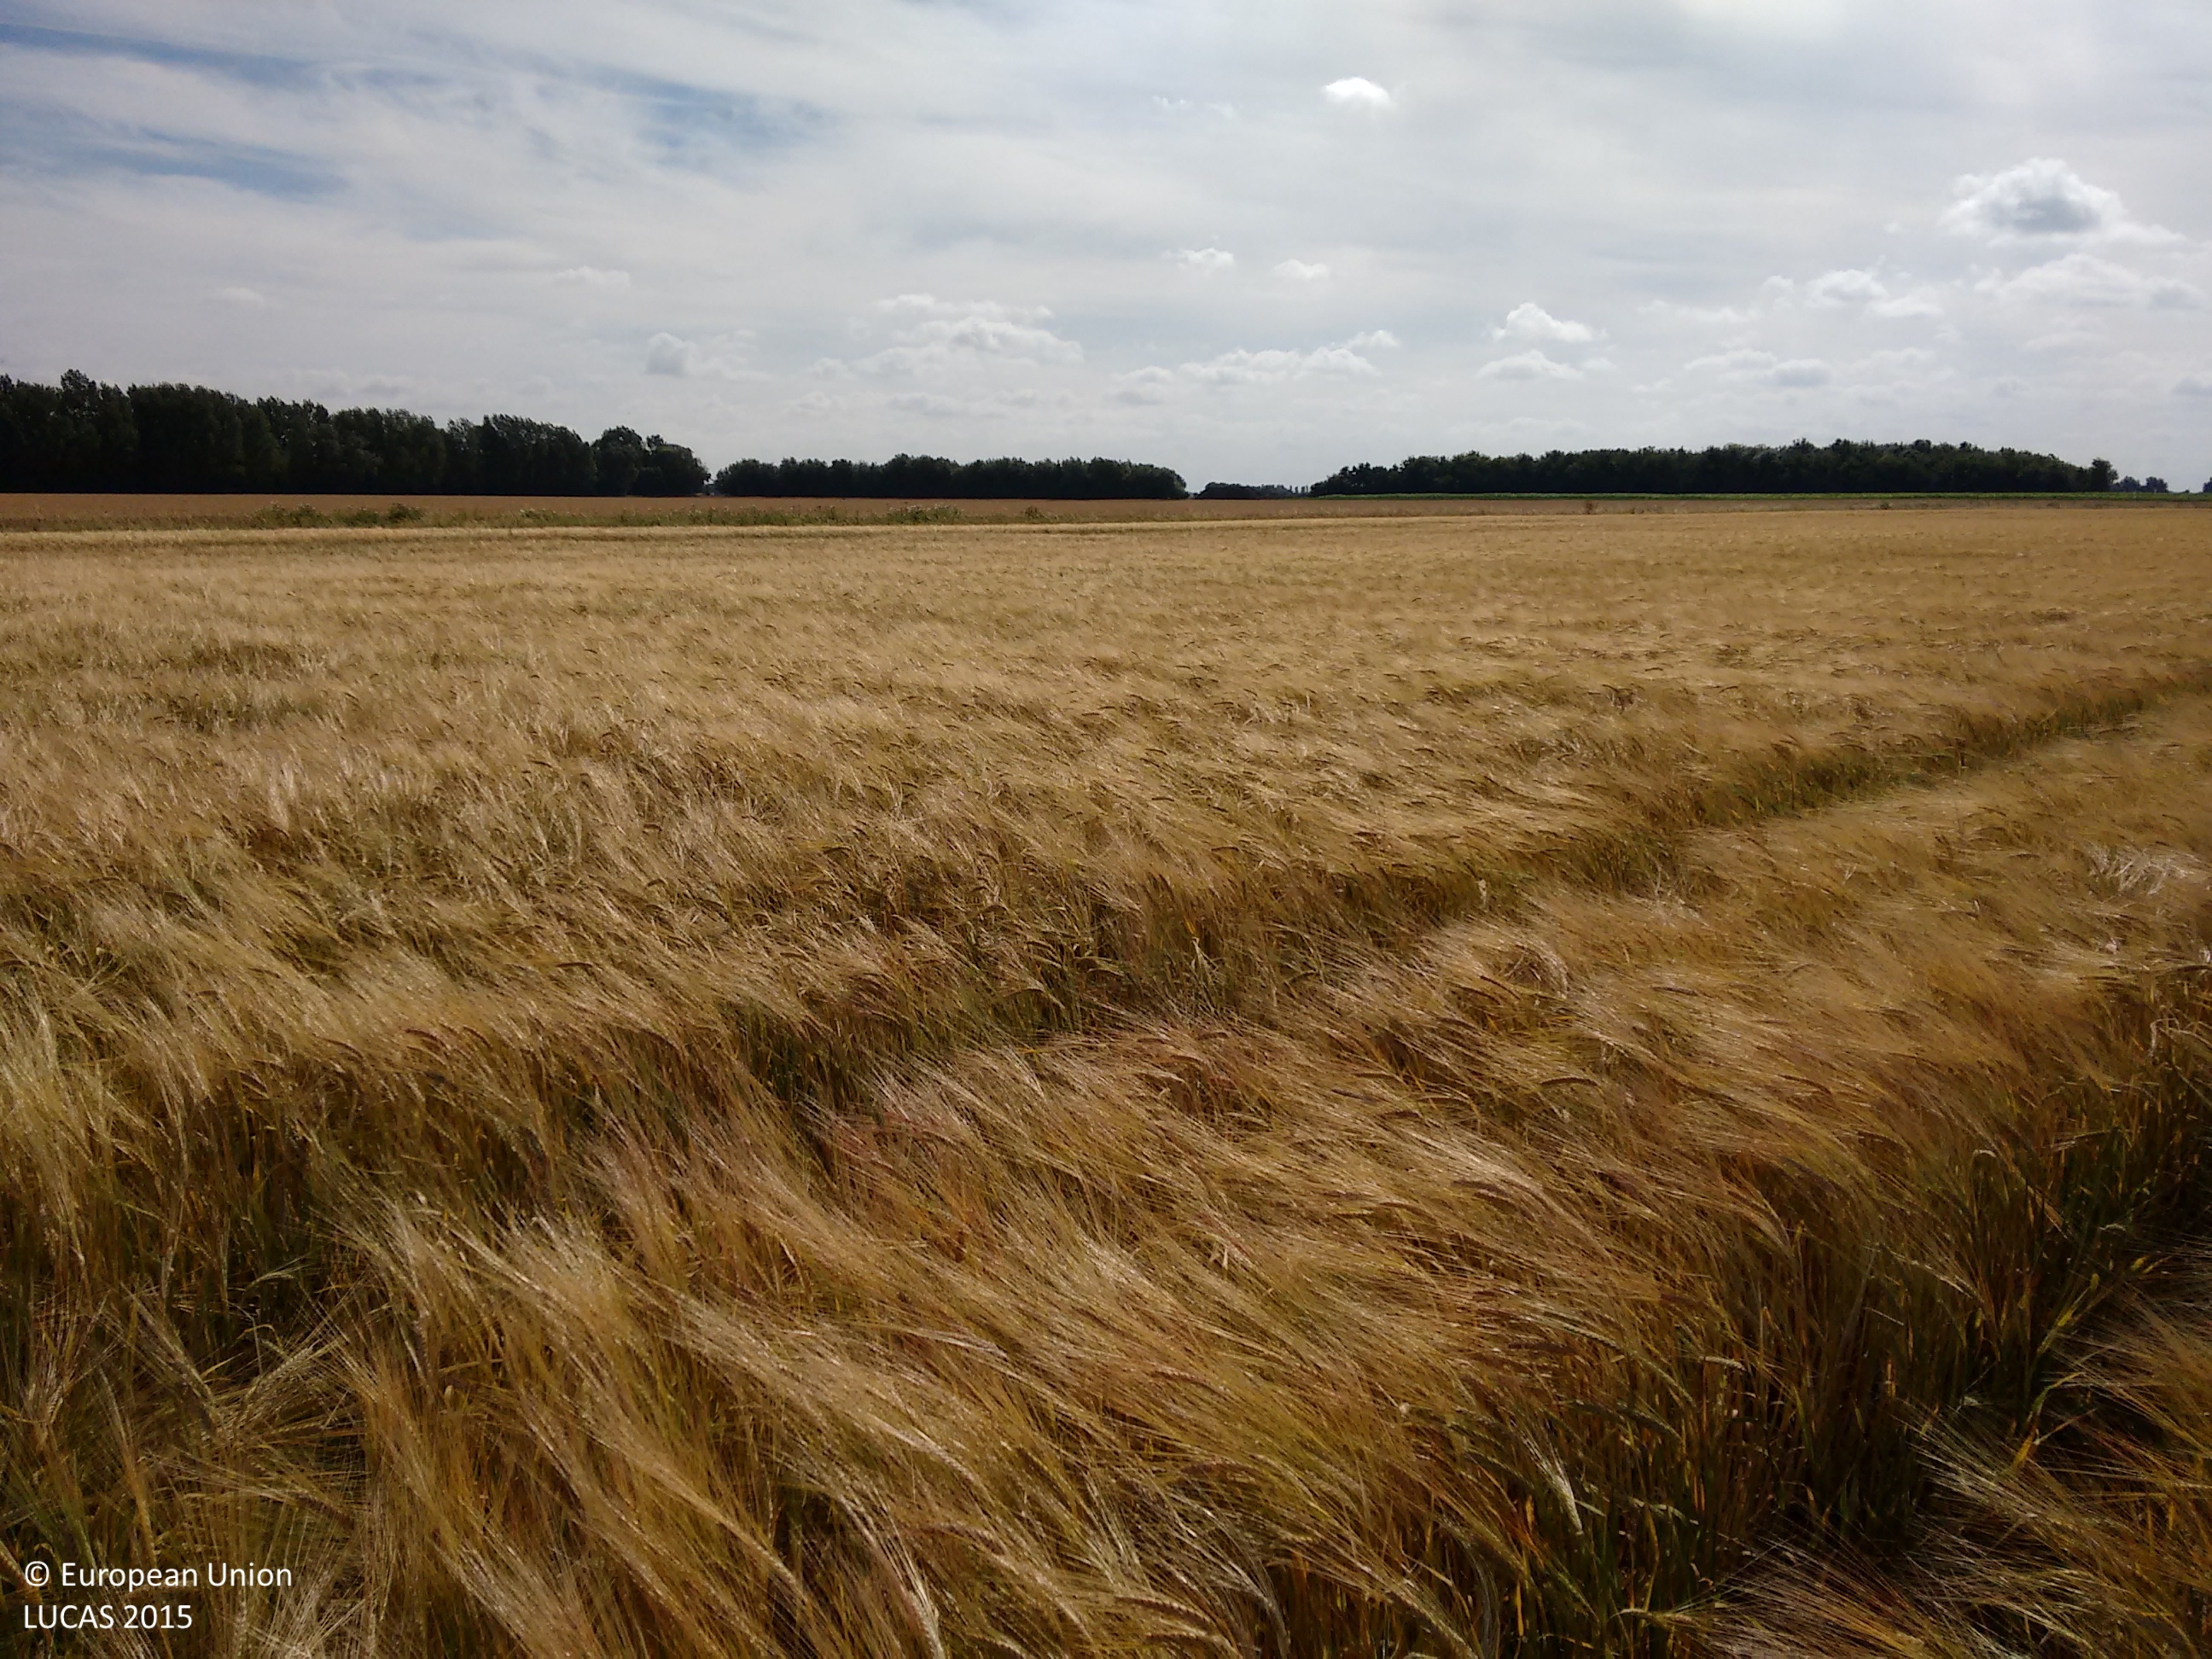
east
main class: Cropland
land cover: Barley
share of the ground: > 75 %
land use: Agriculture (excluding fallow land and kitchen gardens)
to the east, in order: Barley; Grass margins; Ditches and canals; Grass margins; Common wheat
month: August
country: GB
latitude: 52.7957
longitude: 0.3162
